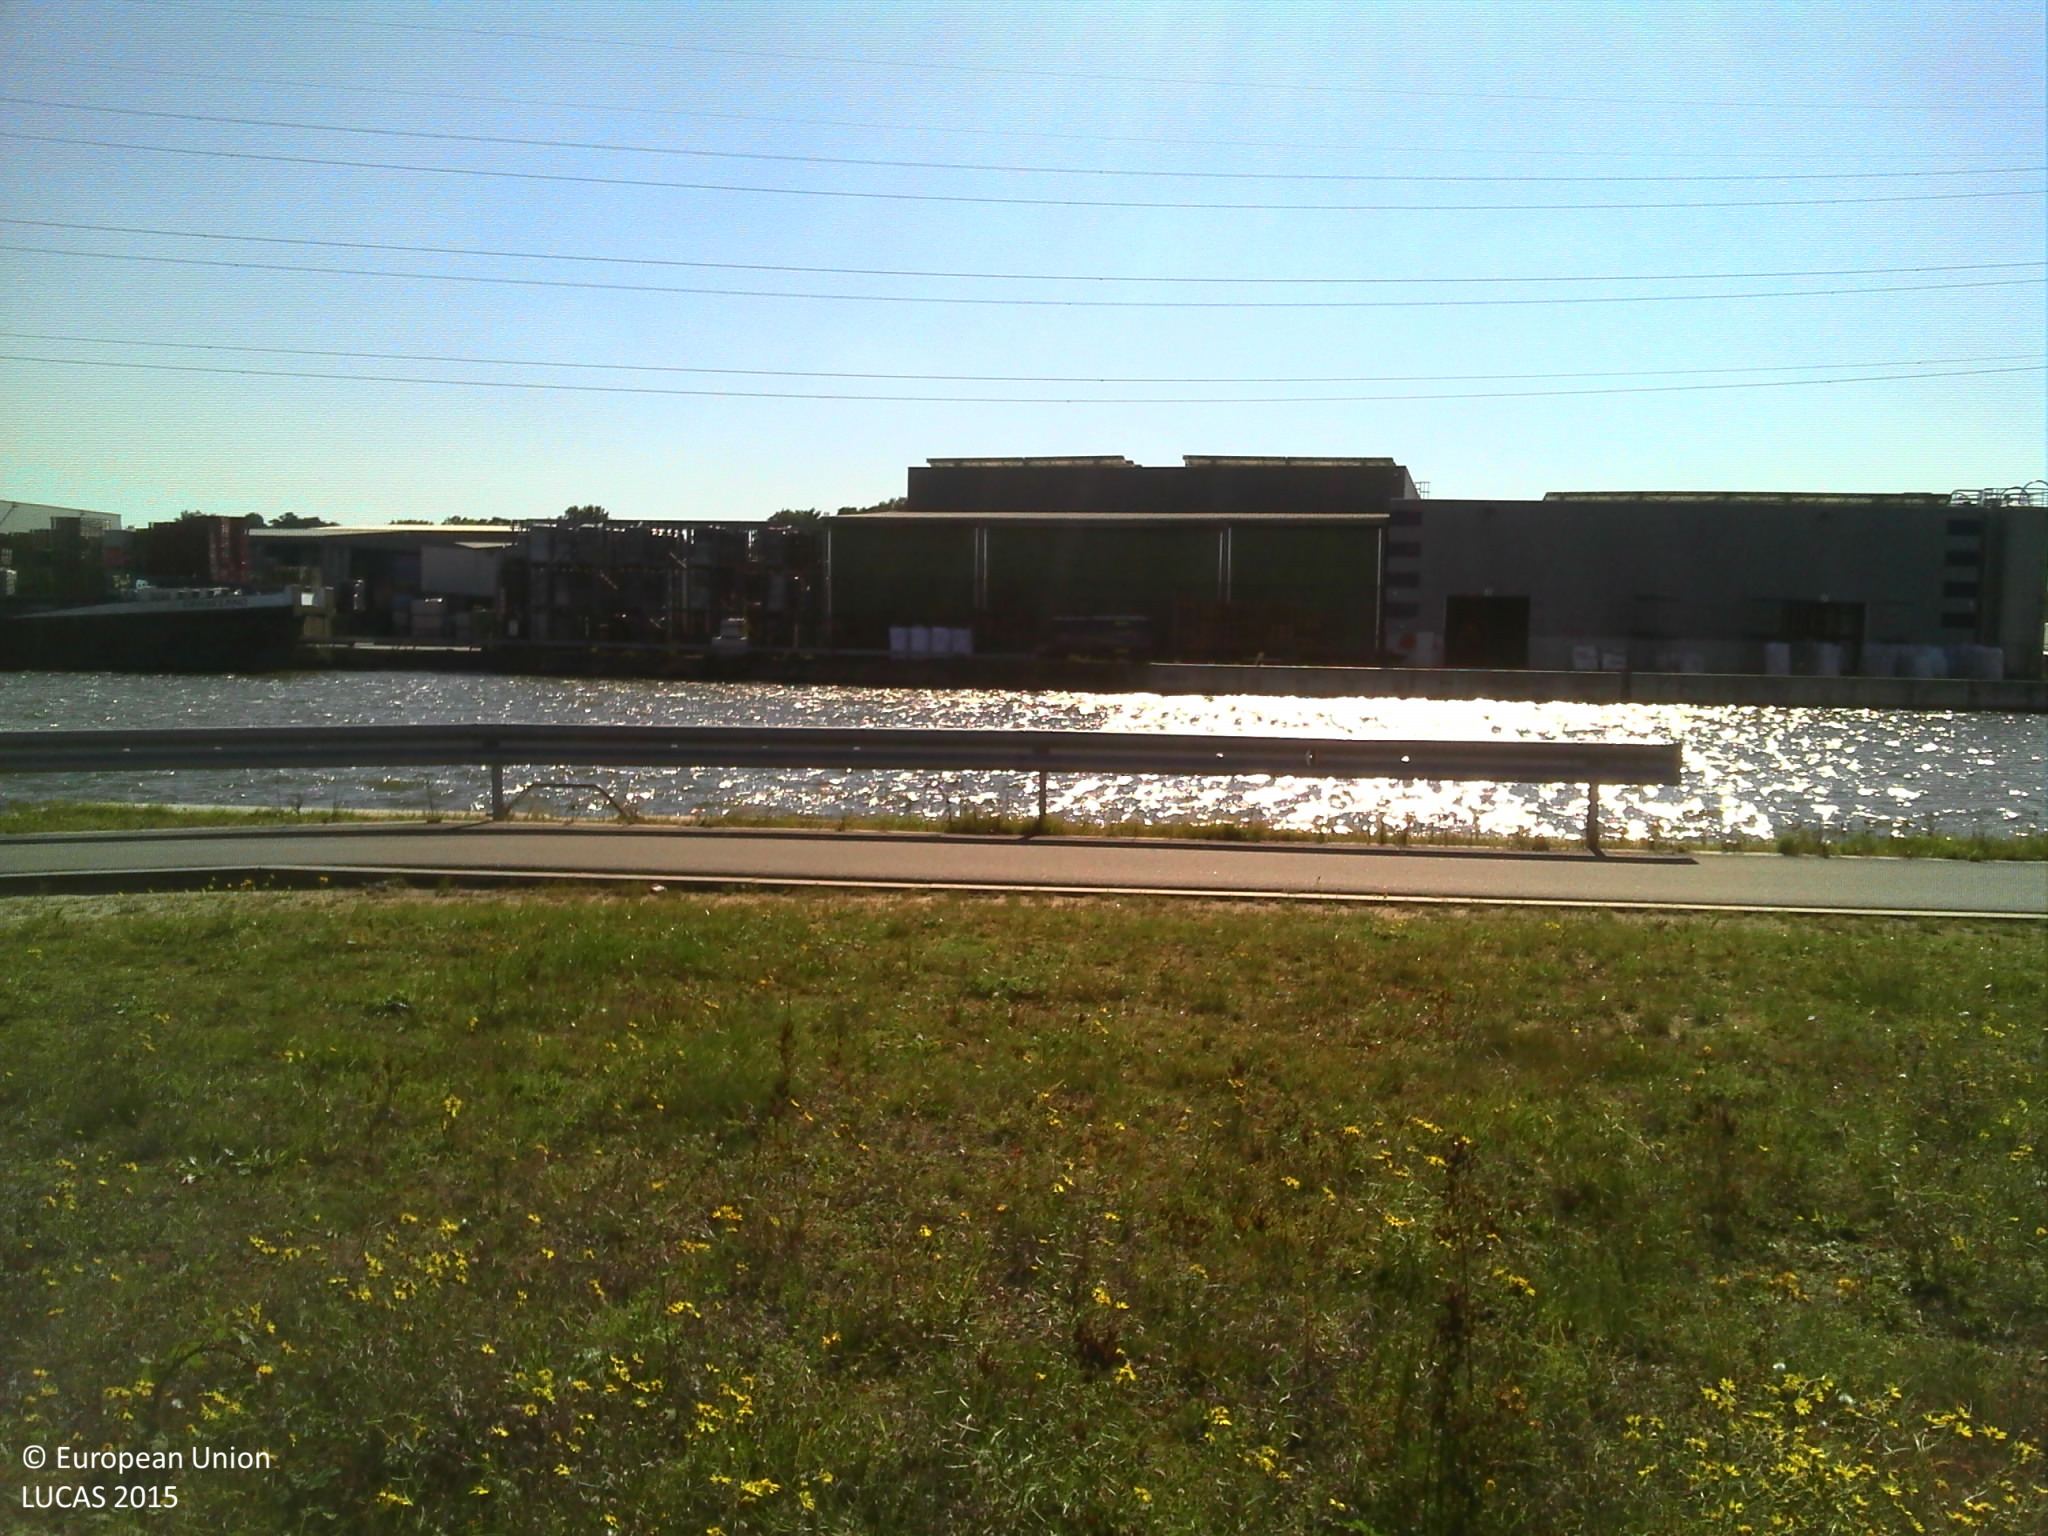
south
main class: Grassland
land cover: Spontaneously vegetated surfaces
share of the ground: > 75 %
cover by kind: herbaceous plants 80 %, unconsolidated bare surface 20 %
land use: Semi-natural and natural areas not in use
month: September
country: BE
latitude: 51.1803
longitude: 4.7464
